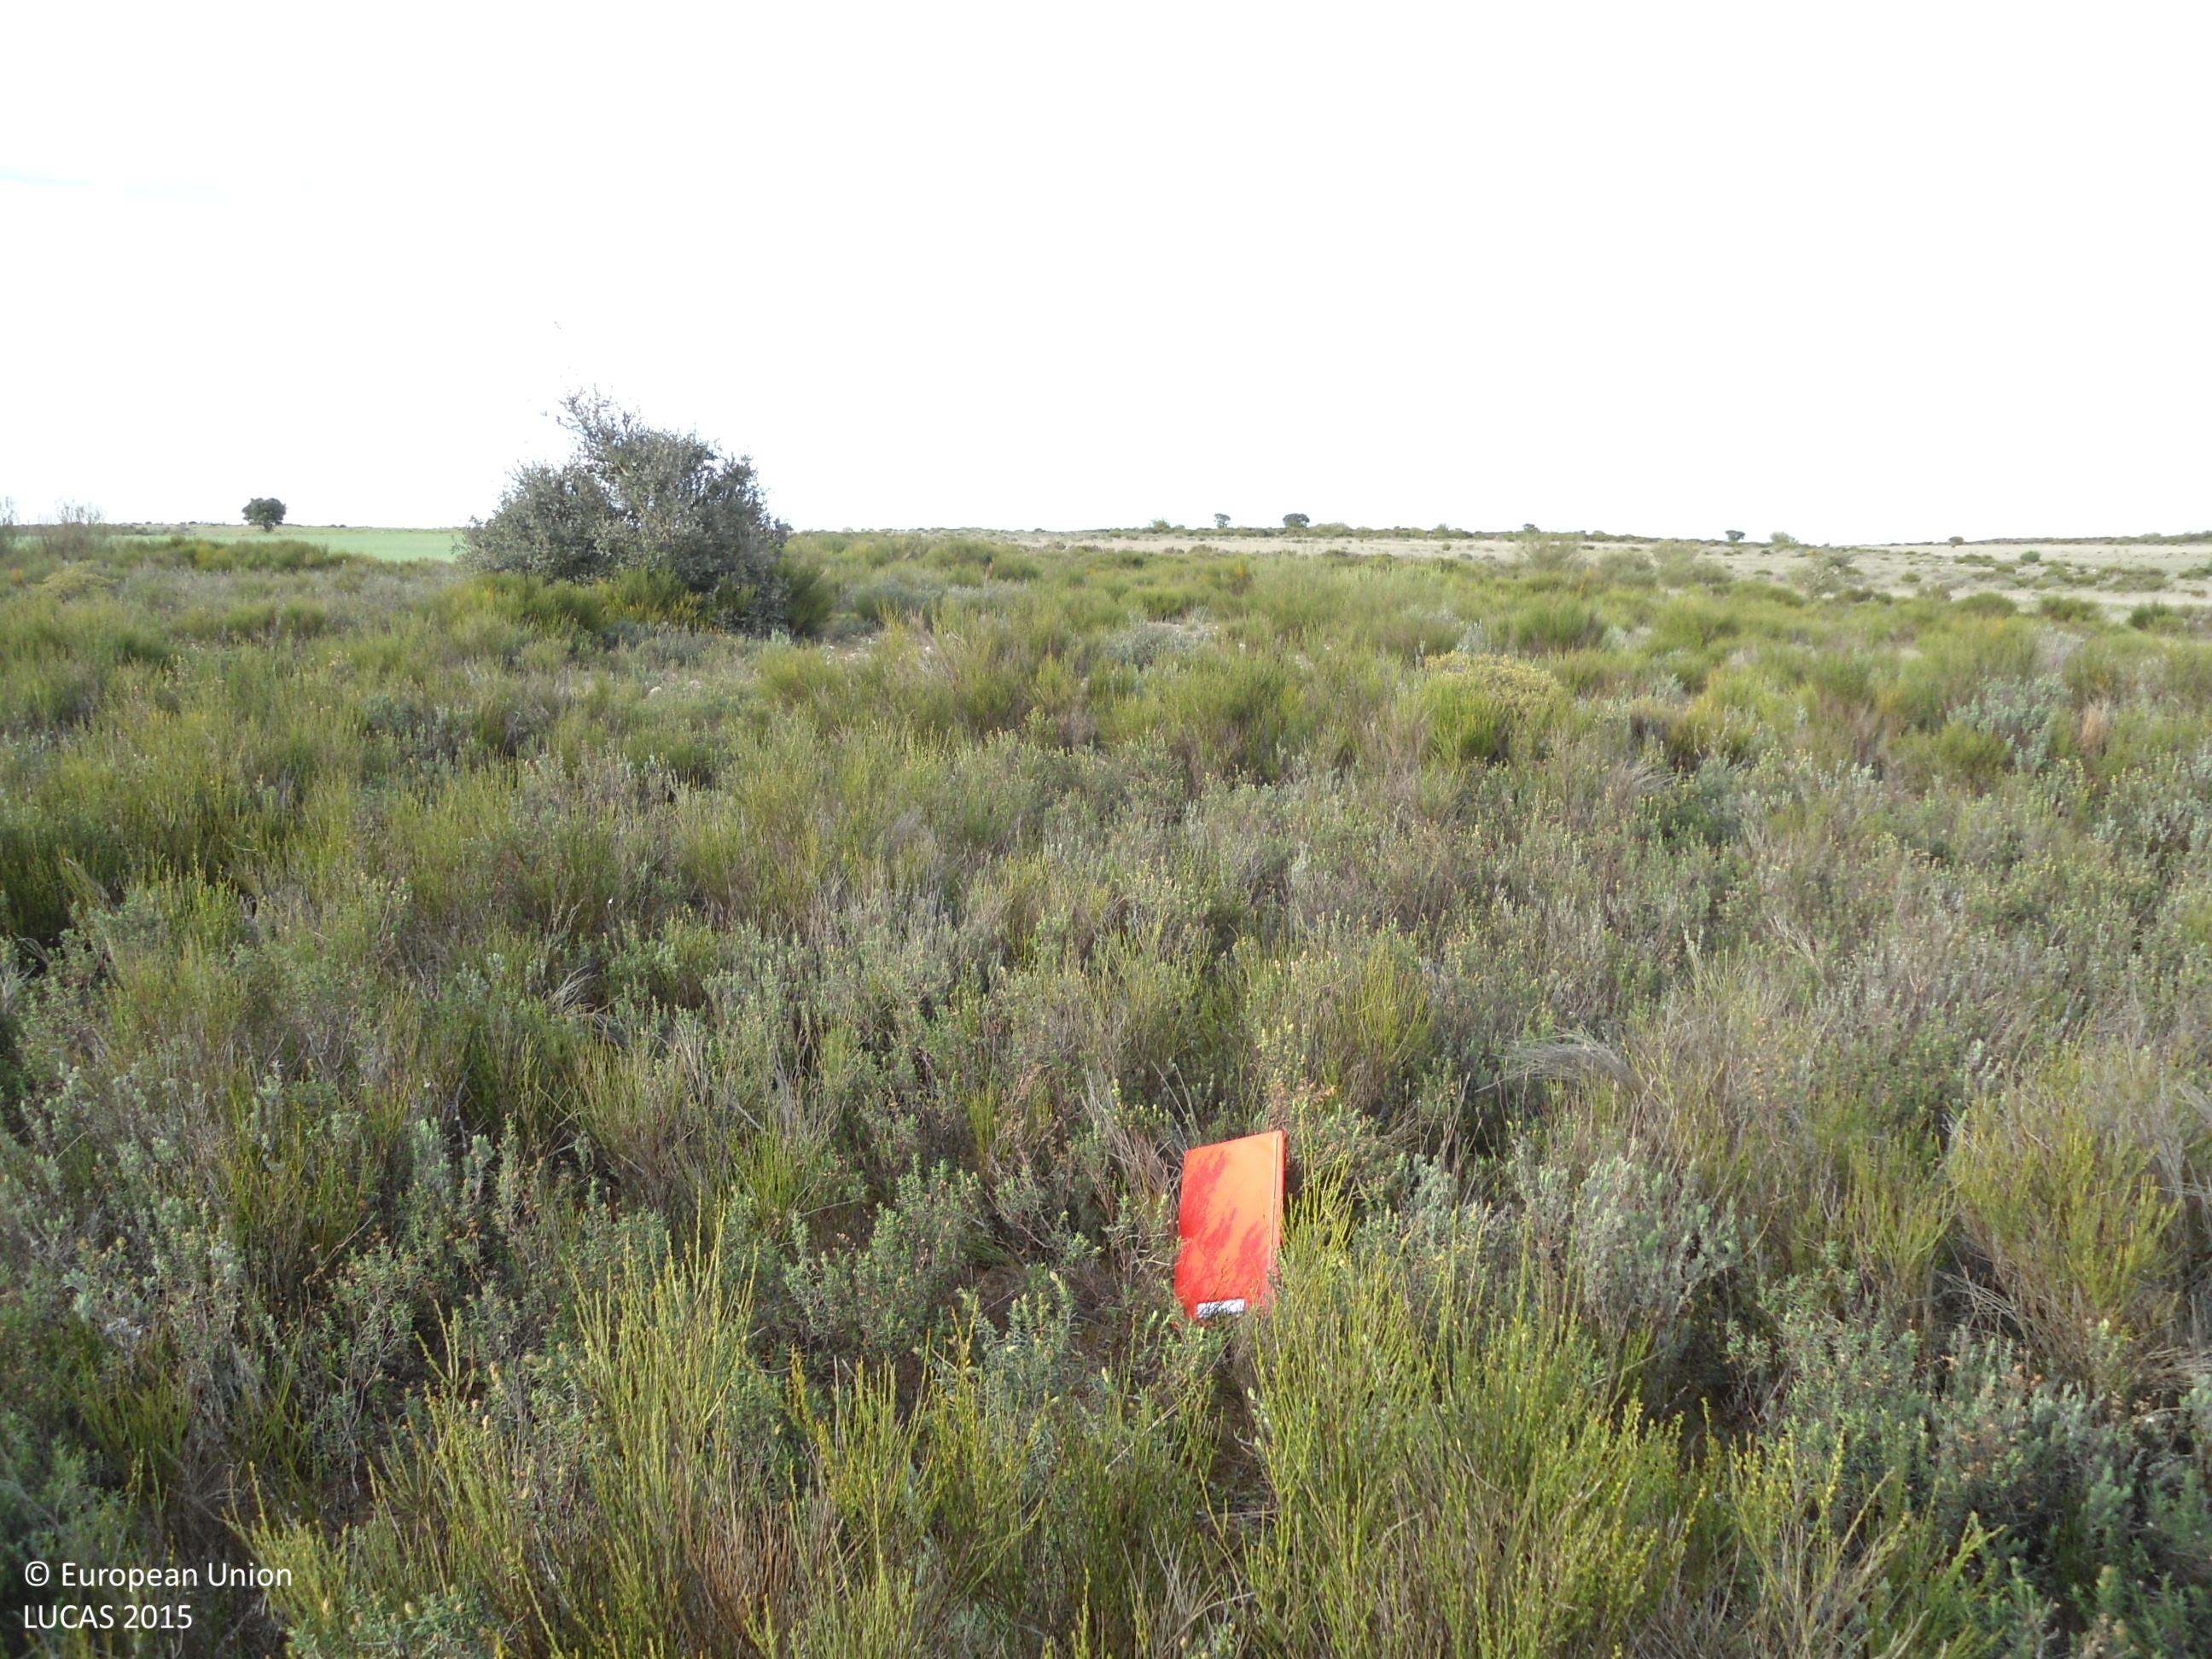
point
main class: Shrubland
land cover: Shrubland without tree cover
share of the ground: > 75 %
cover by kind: shrubs 90 %, herbaceous plants 10 %
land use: Fallow land
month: April
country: ES
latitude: 41.5795
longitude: -6.0828
